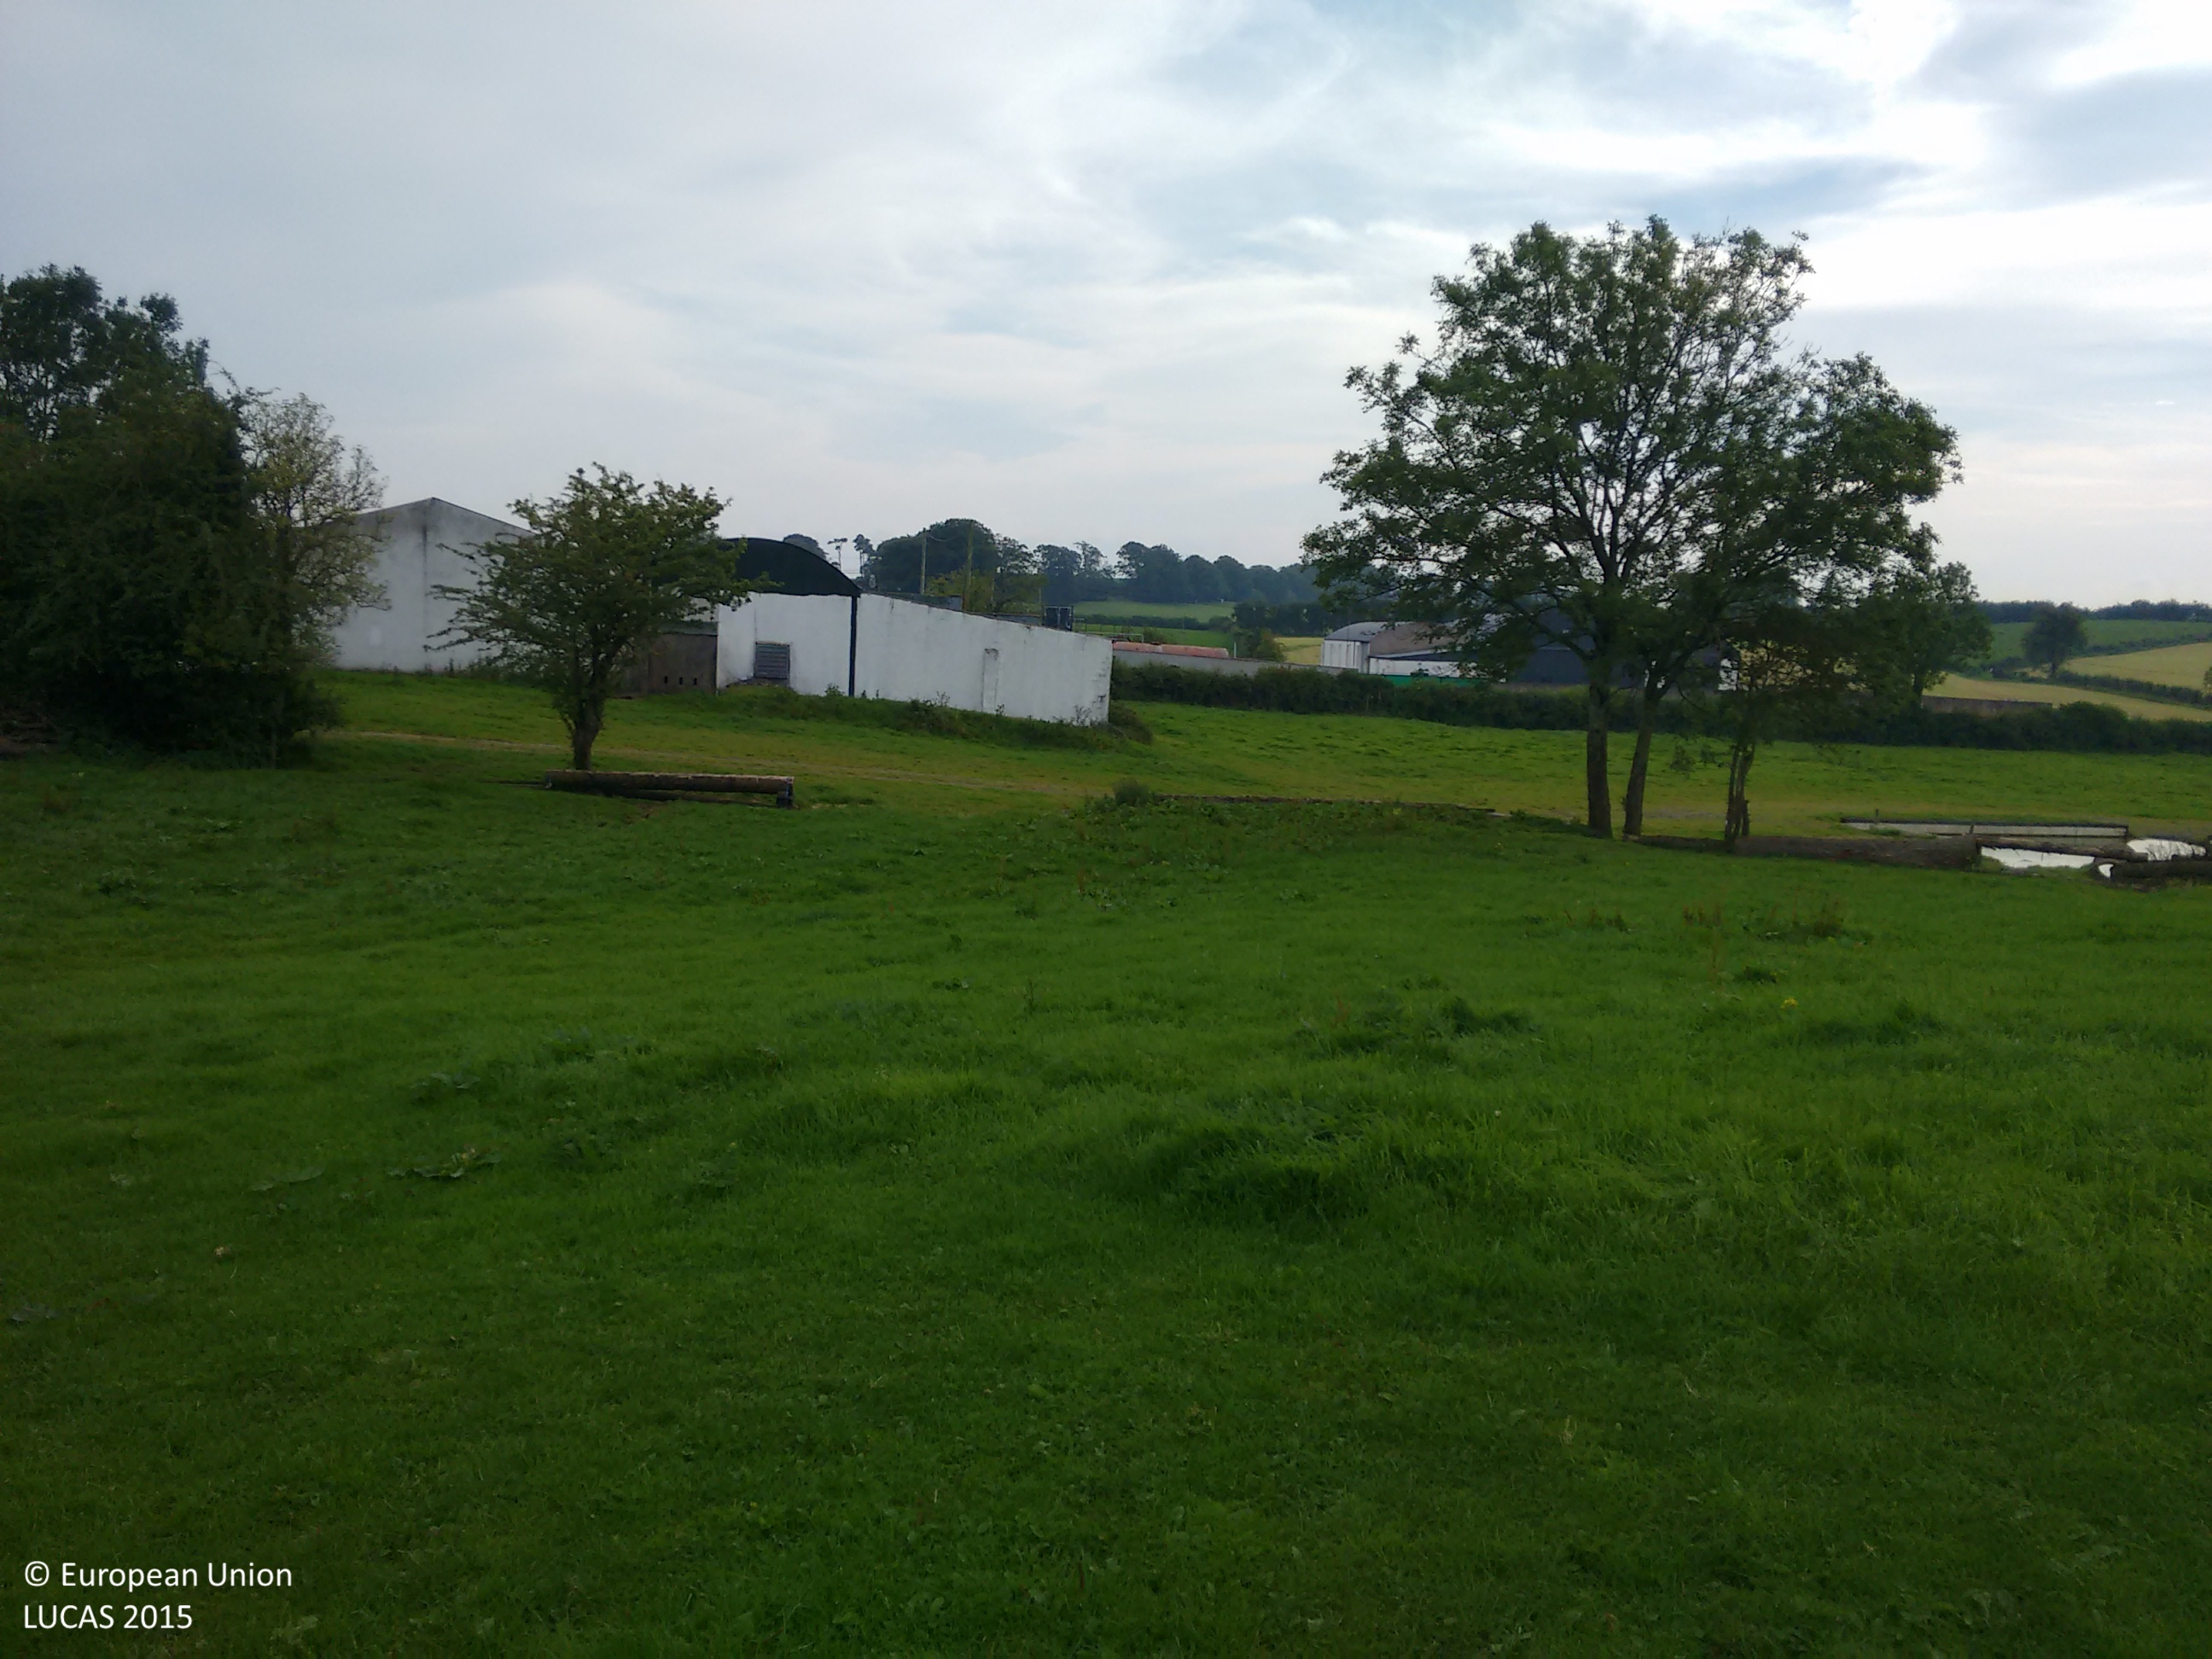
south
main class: Grassland
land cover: Grassland without tree/shrub cover
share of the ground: > 75 %
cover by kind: herbaceous plants 100 %
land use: Agriculture (excluding fallow land and kitchen gardens)
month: September
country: IE
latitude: 54.3163
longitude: -6.9086
